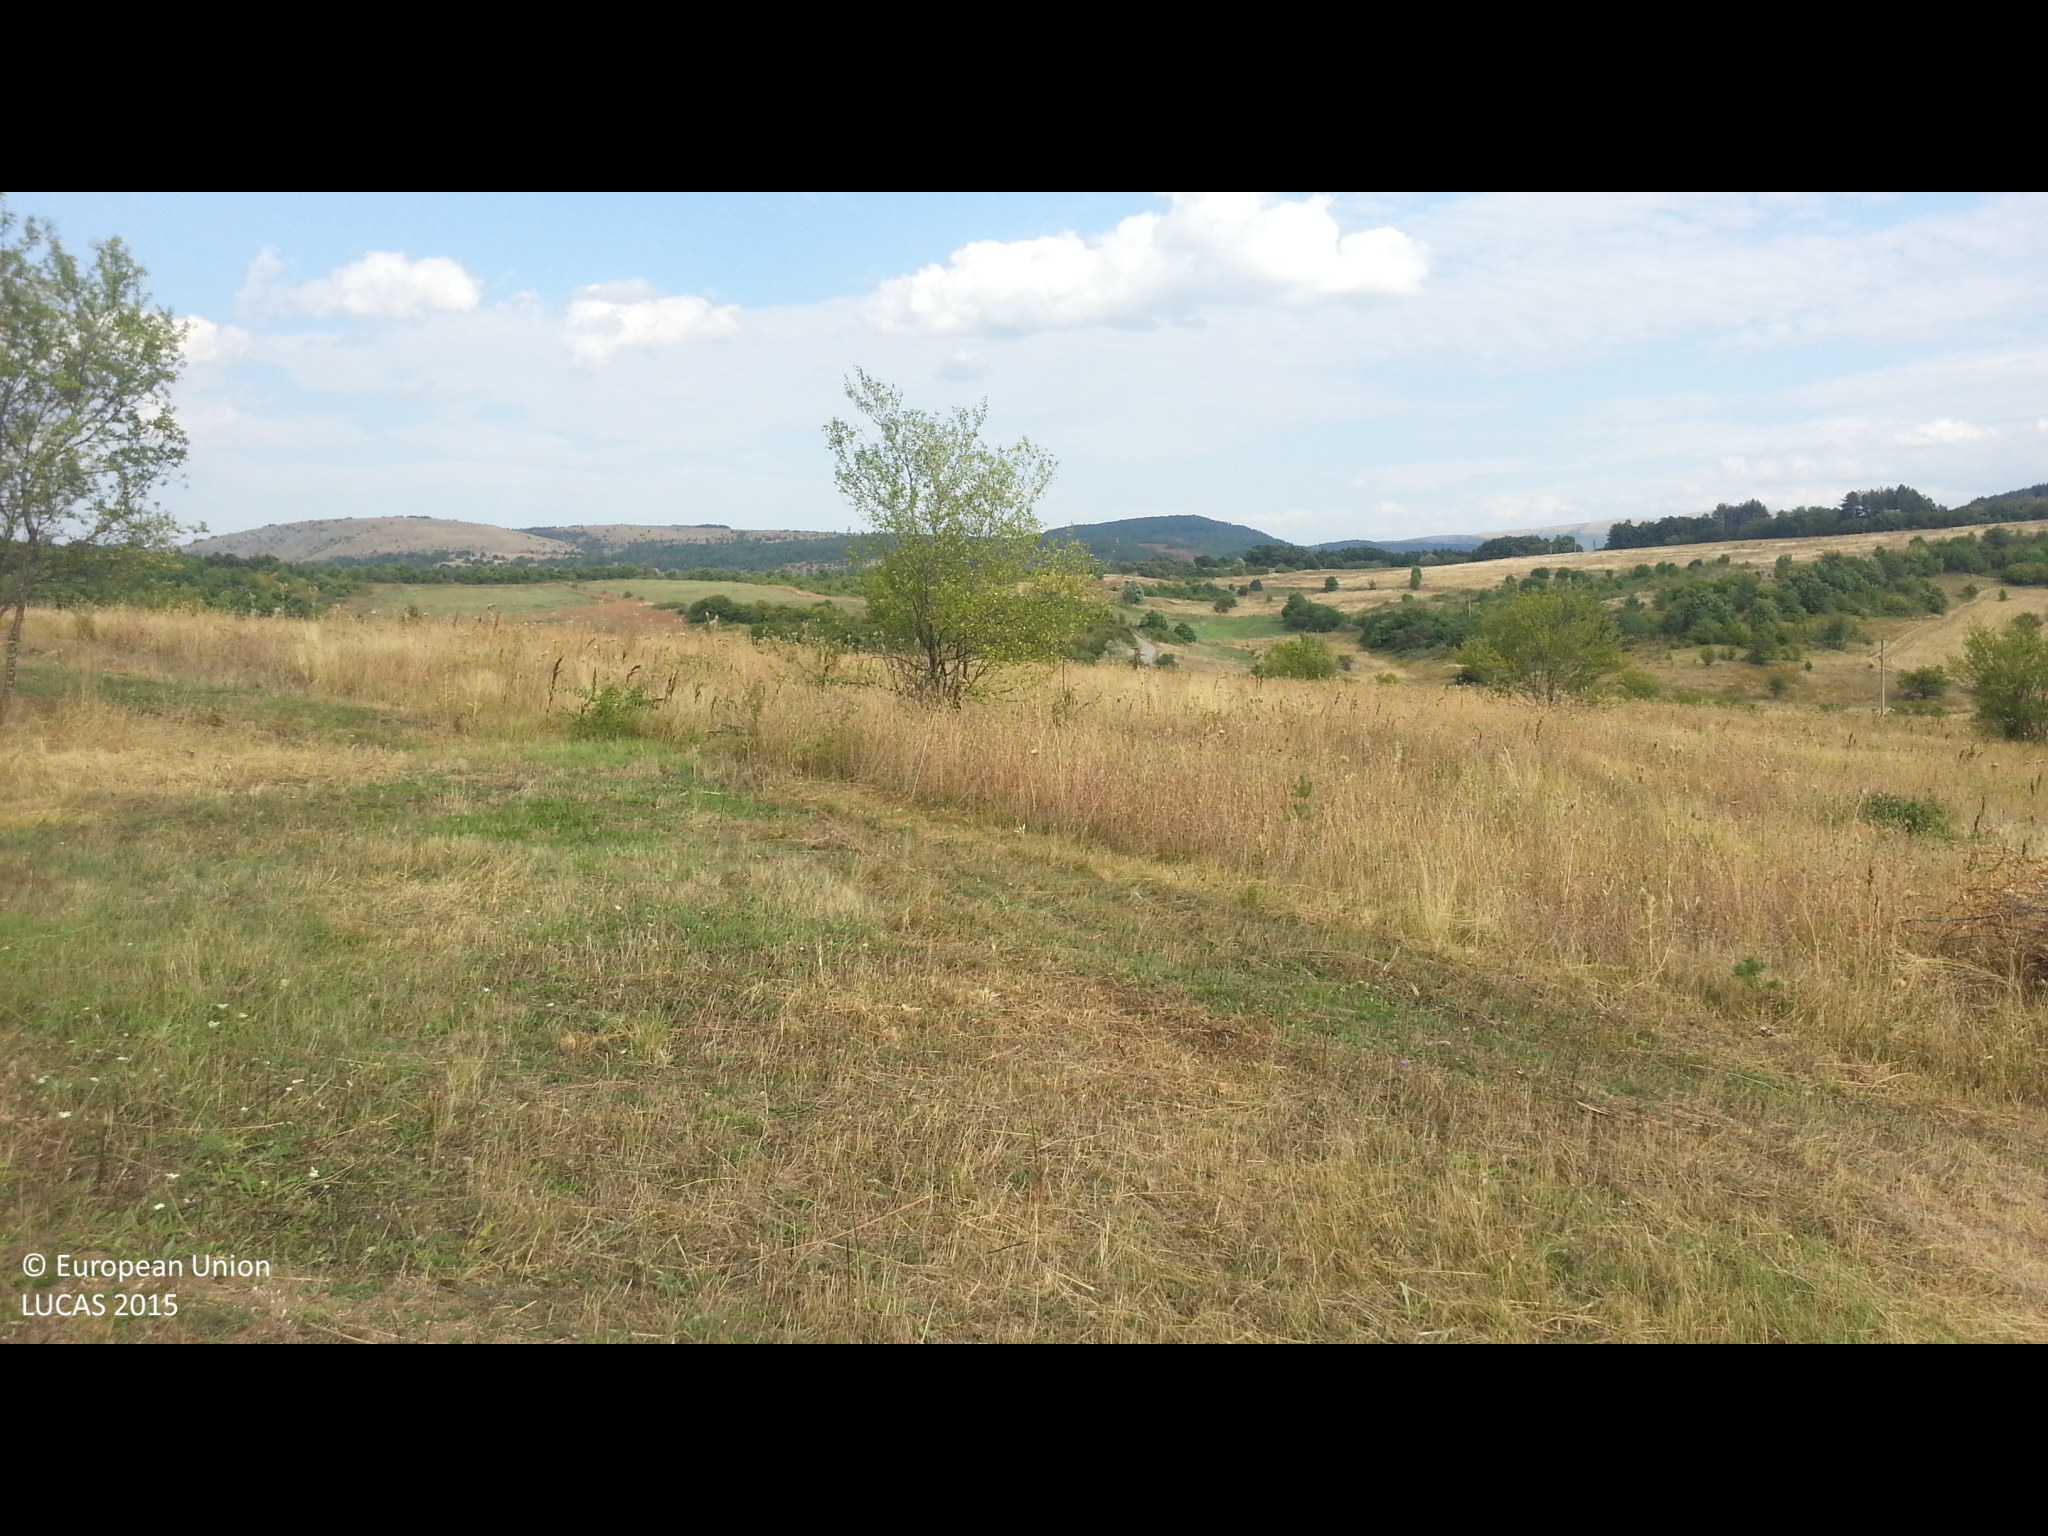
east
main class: Grassland
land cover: Grassland without tree/shrub cover
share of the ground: > 75 %
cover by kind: herbaceous plants 100 %
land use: Agriculture (excluding fallow land and kitchen gardens)
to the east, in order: Grassland without tree/shrub cover; Electric lines; Grassland with sparse tree/shrub cover; Grassland without tree/shrub cover
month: September
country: BG
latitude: 42.4649
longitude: 22.6099
